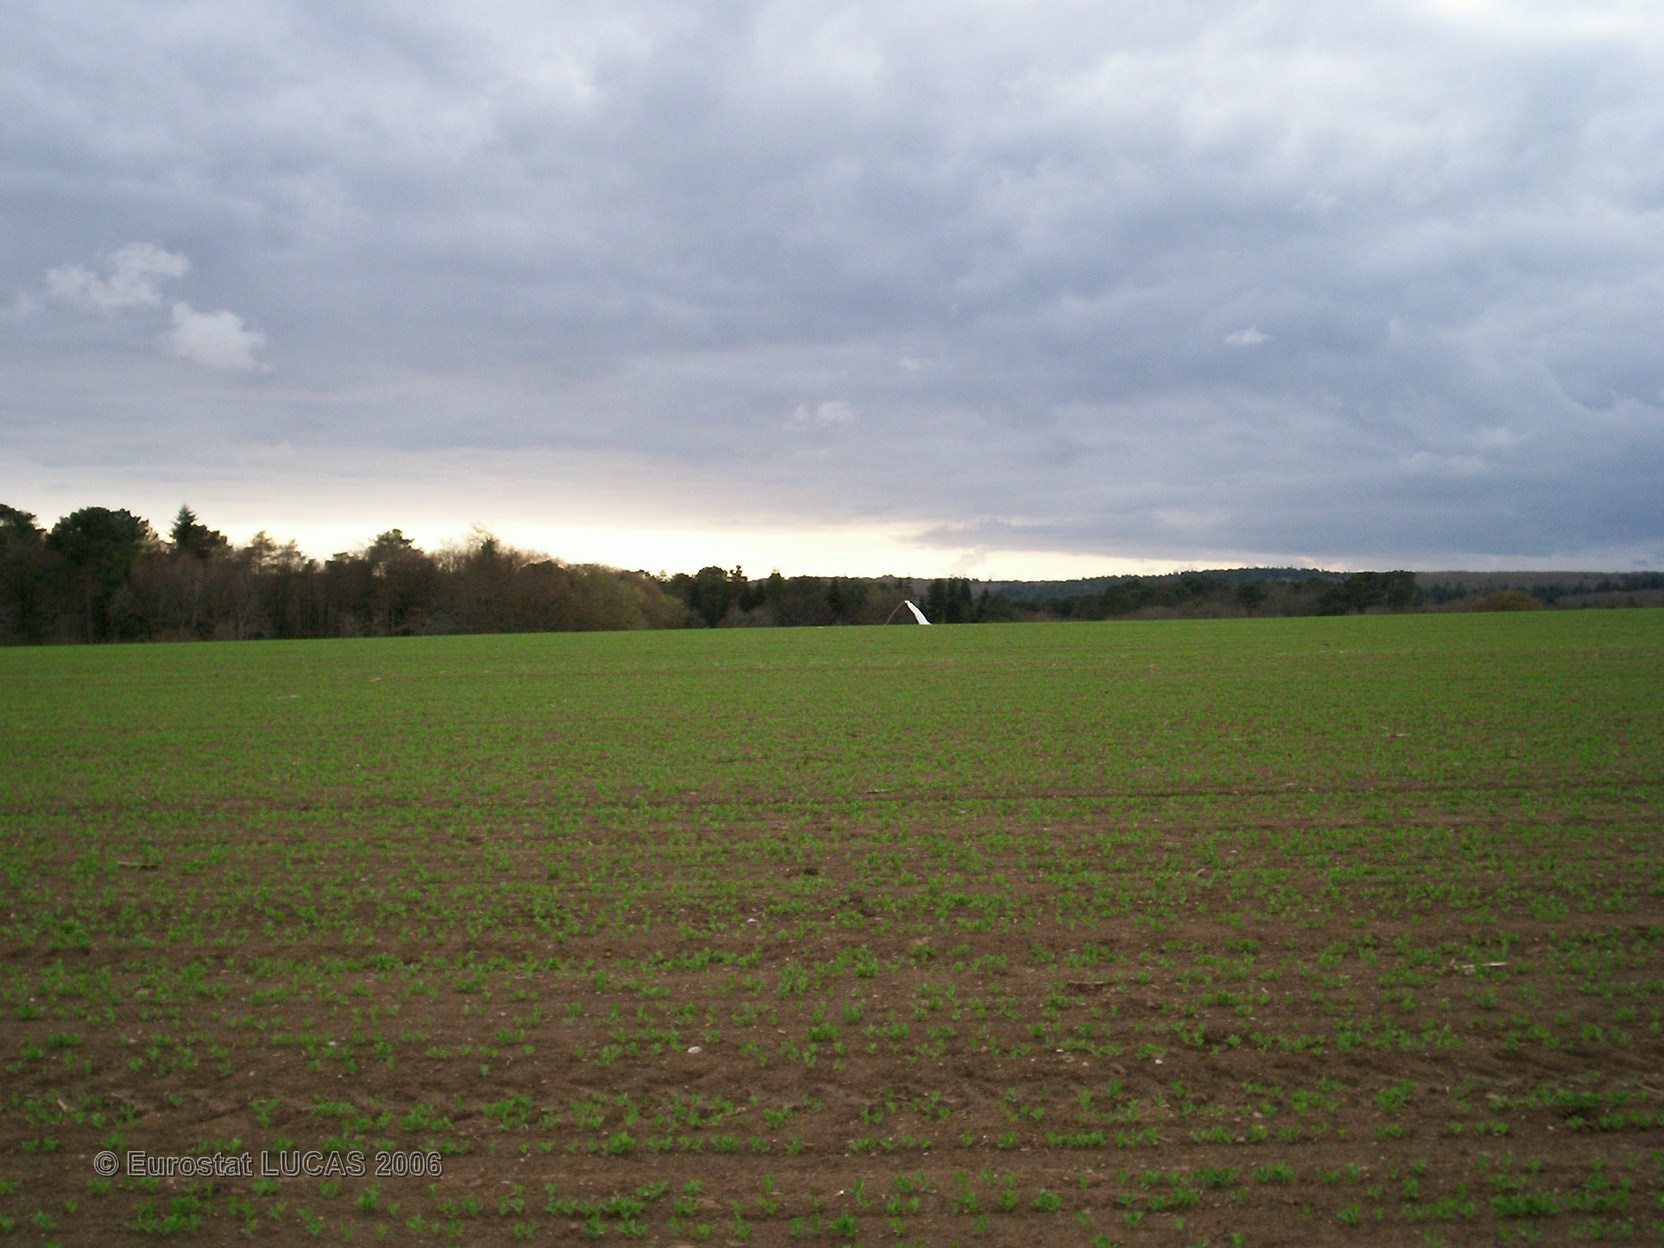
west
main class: Cropland
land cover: Dry pulses
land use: Agriculture (excluding fallow land and kitchen gardens)
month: April
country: FR
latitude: 47.8229
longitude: -3.5267
